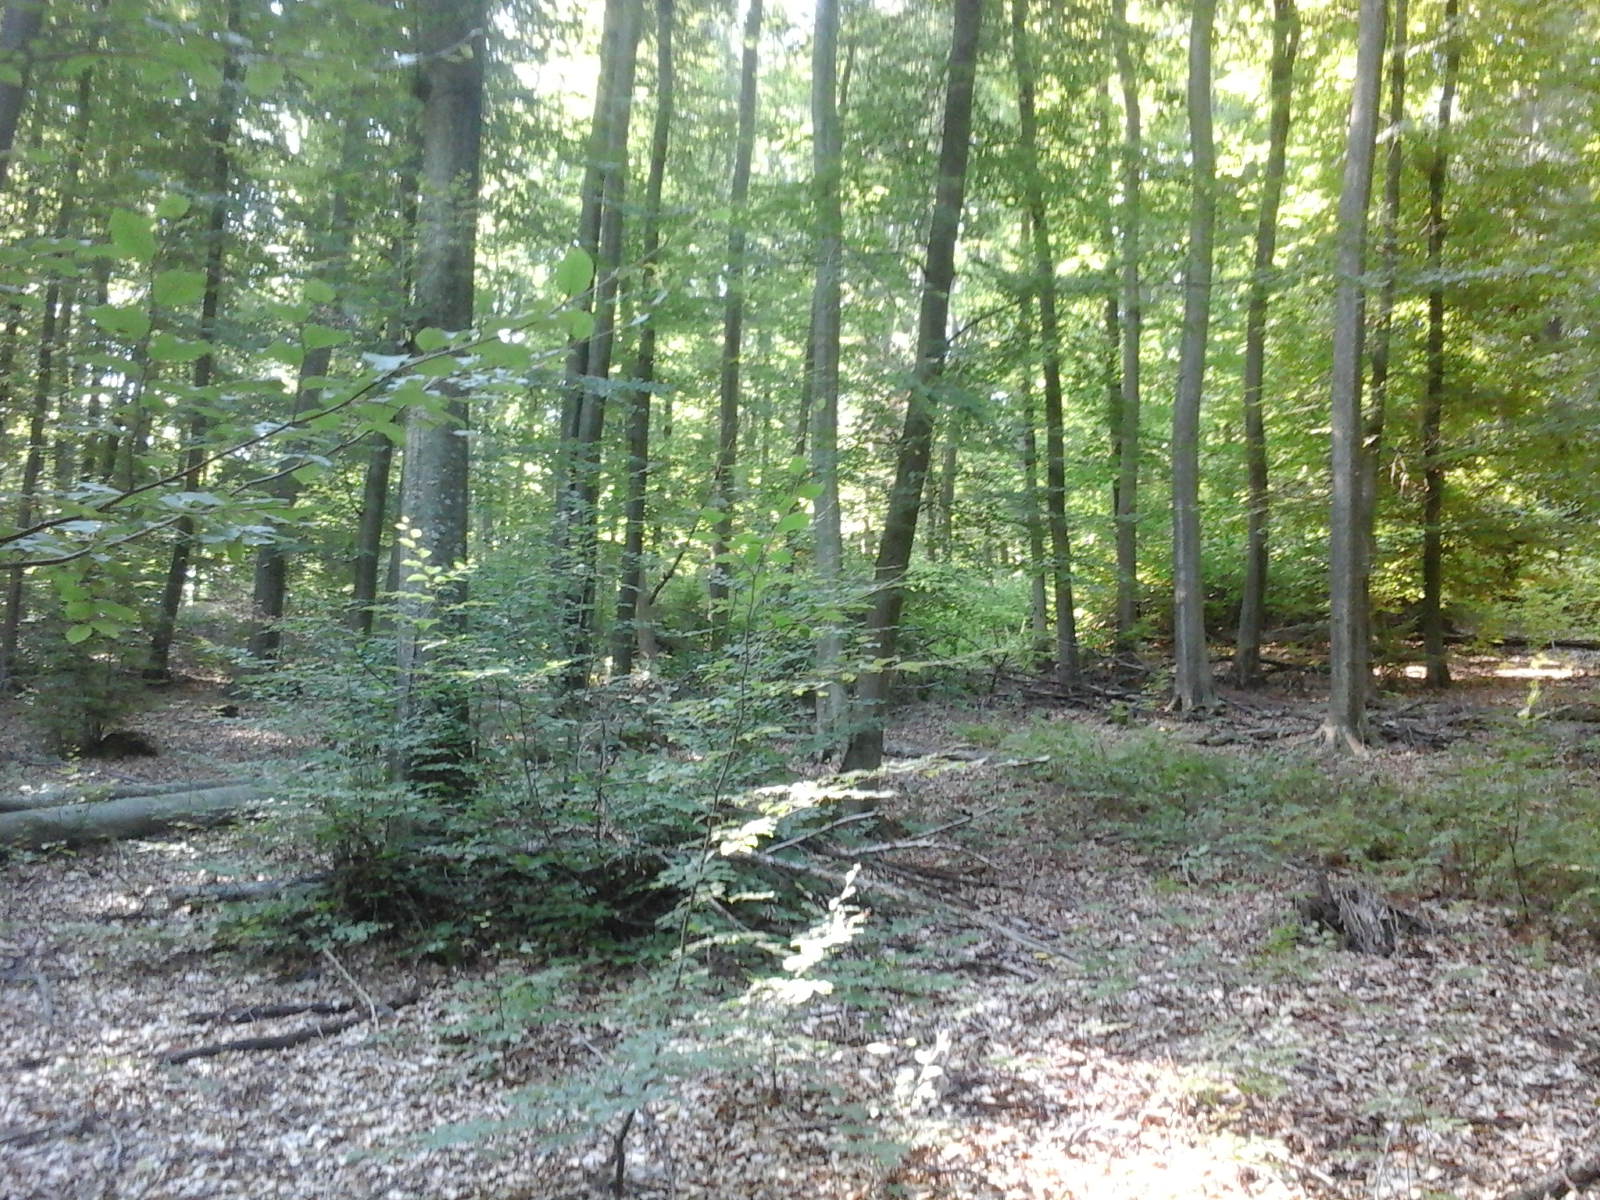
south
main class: Woodland
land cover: Broadleaved woodland
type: beech forest
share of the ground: > 75 %
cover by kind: broadleaved forest trees 100 %
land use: Forestry
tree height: > 5 m
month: August
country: RO
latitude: 46.0143
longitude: 22.1980
